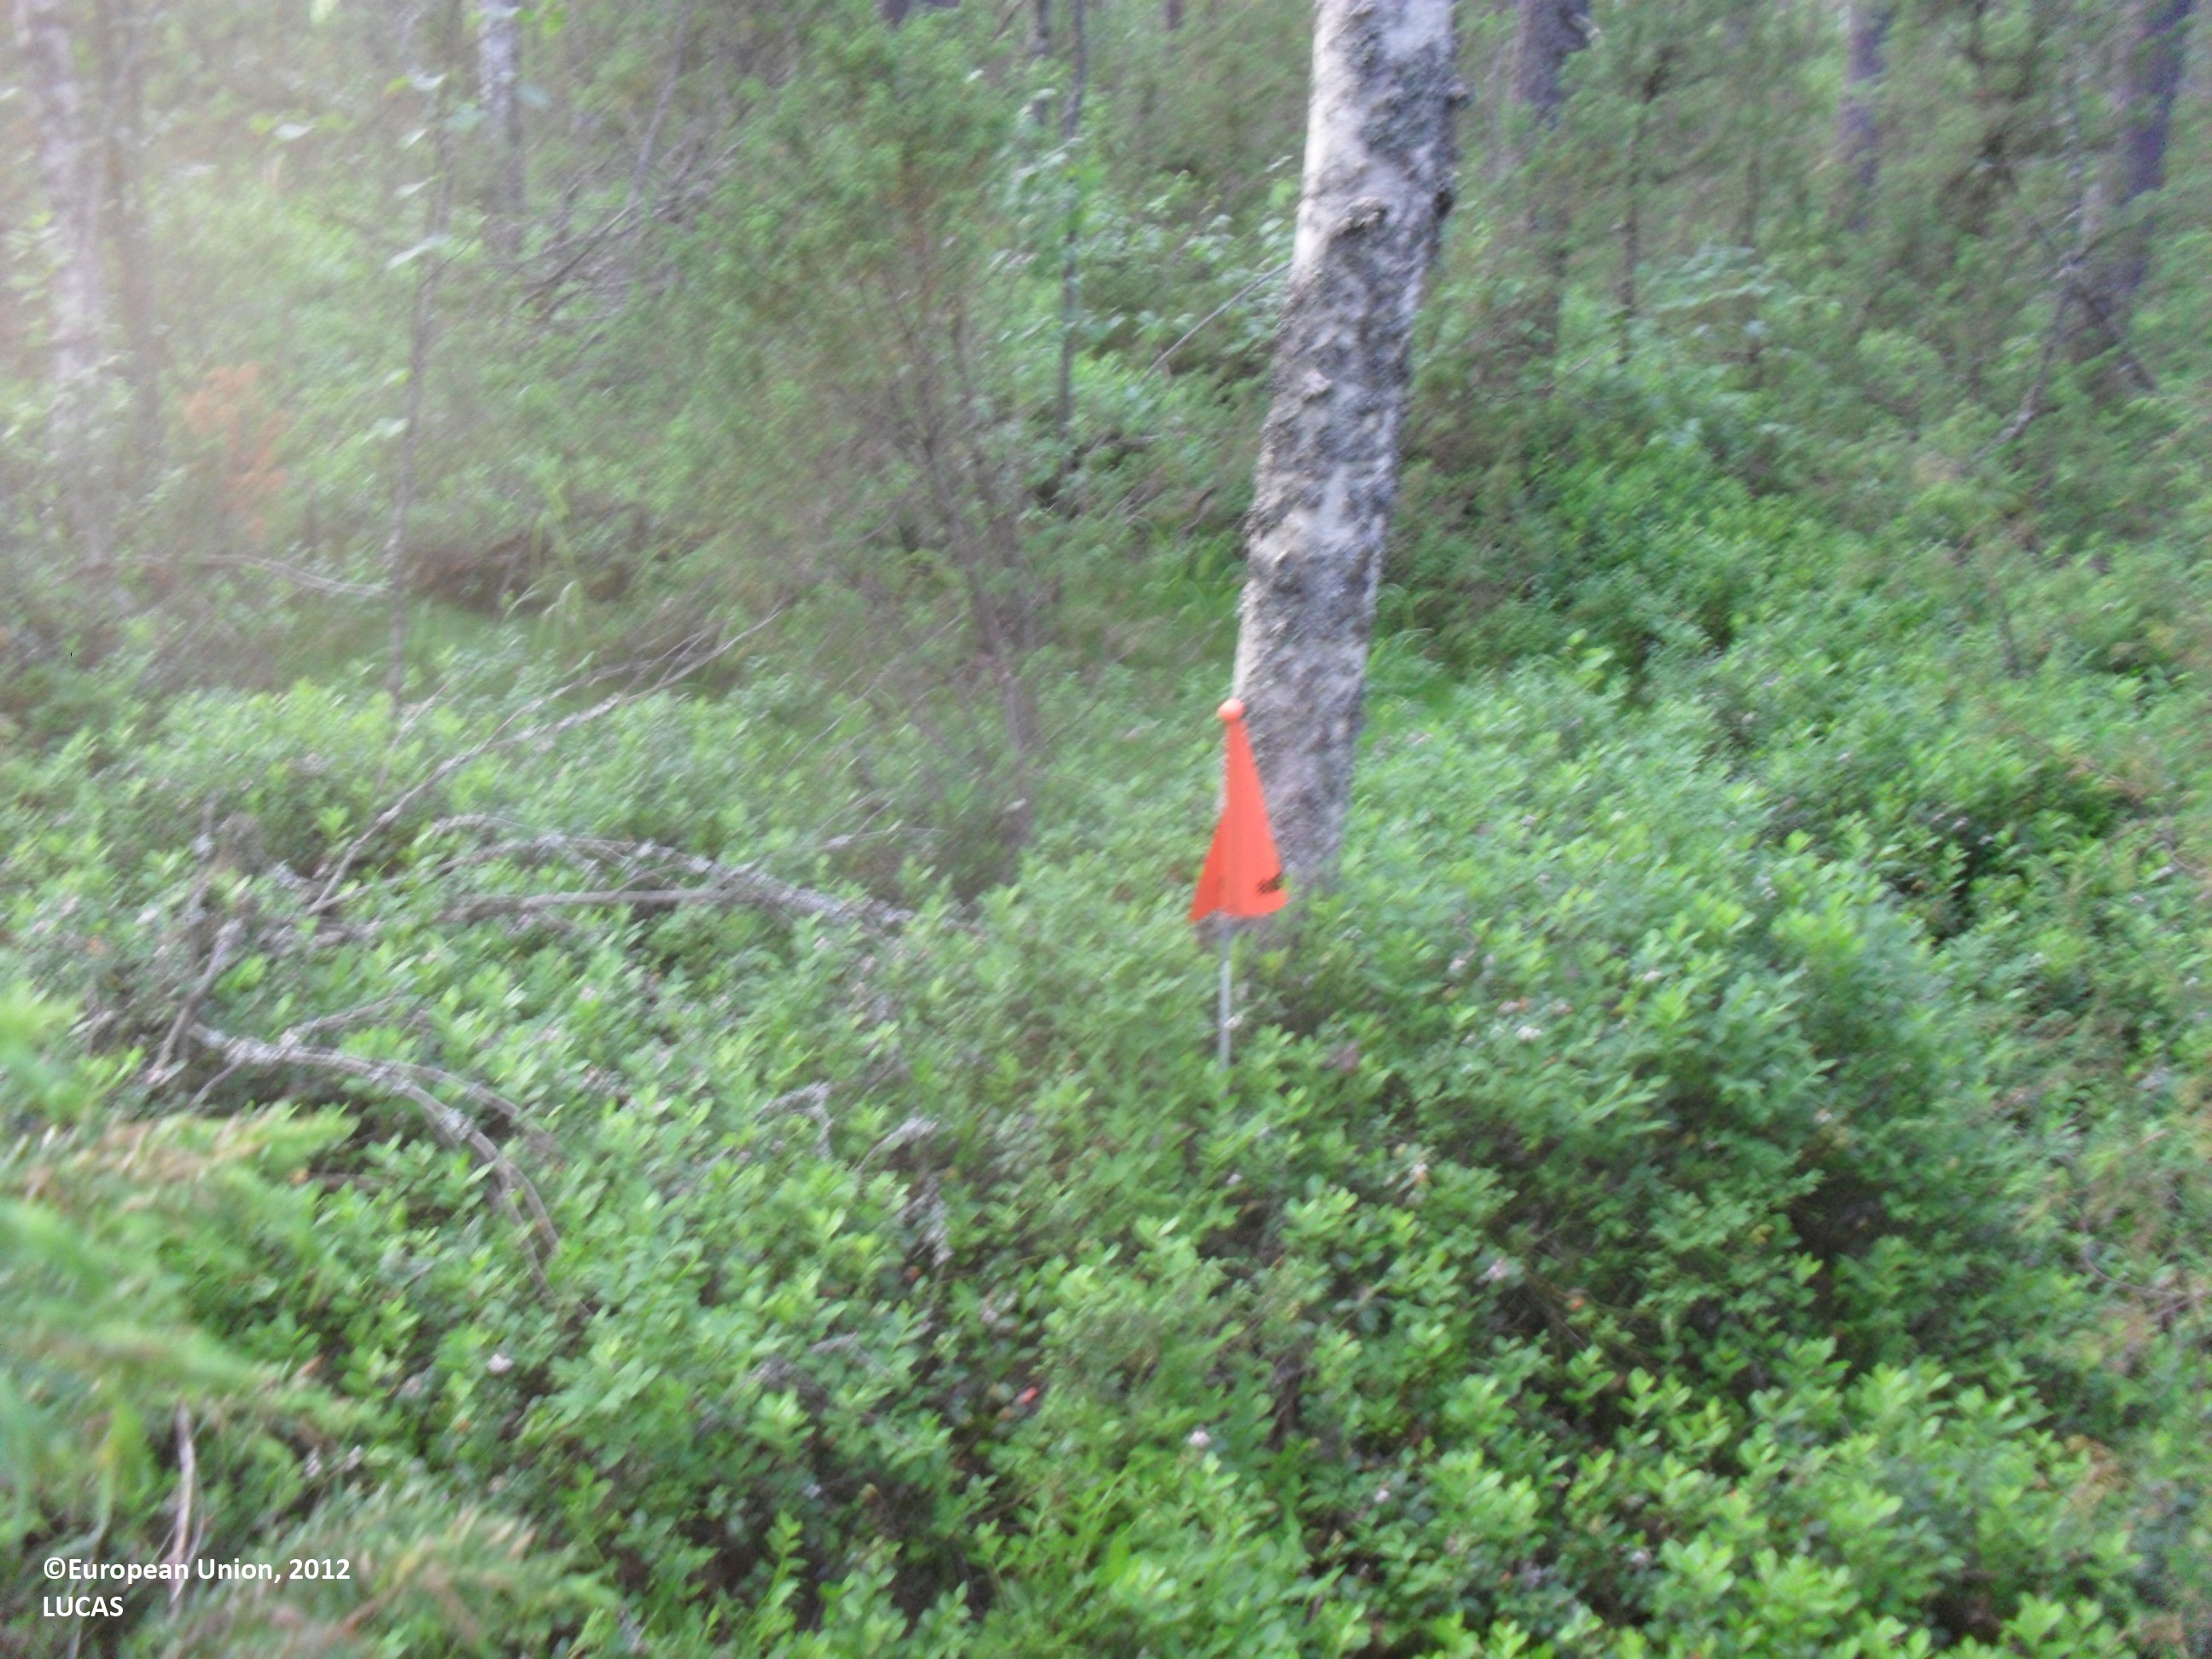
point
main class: Woodland
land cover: Other mixed woodland
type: boreal forest
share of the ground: 50 - 75 %
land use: Forestry
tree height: > 5 m
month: July
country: FI
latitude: 63.0467
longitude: 24.2989
